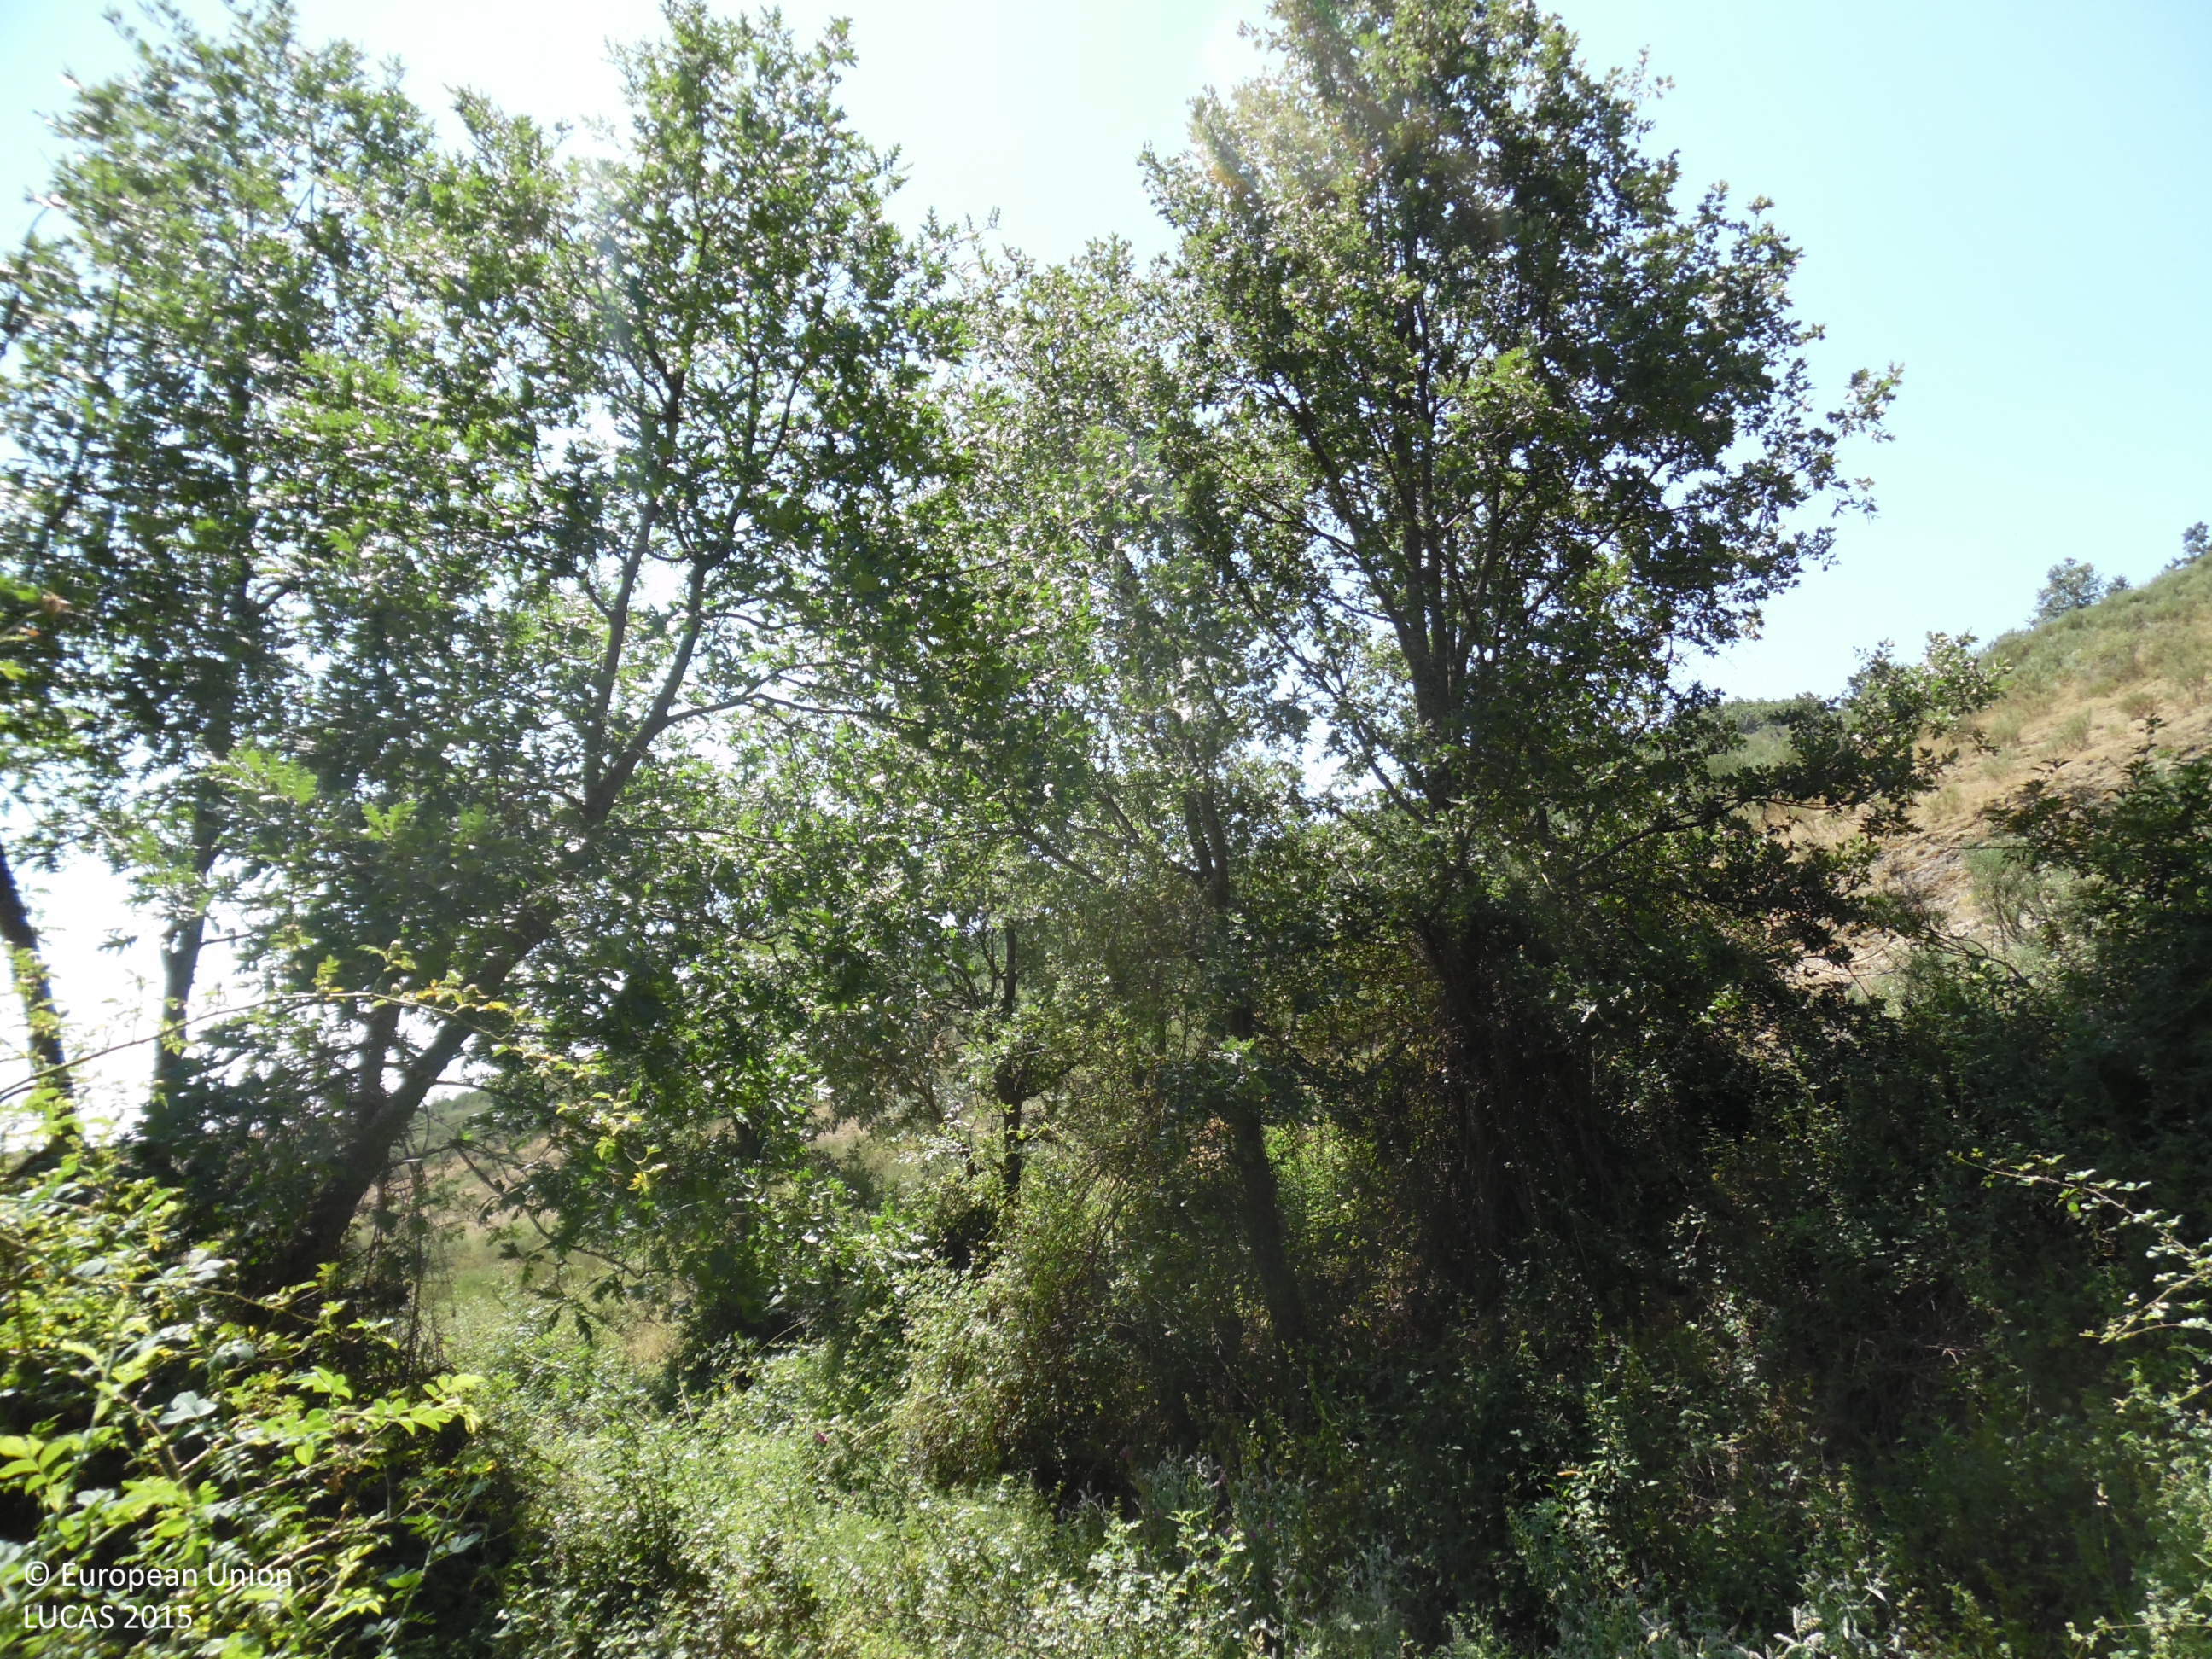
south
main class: Shrubland
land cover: Shrubland with sparse tree cover
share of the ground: > 75 %
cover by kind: shrubs 95 %, broadleaved forest trees 5 %
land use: Abandoned areas
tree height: > 5 m
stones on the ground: 10 - 25 %
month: July
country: ES
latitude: 42.8117
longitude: -5.8450
